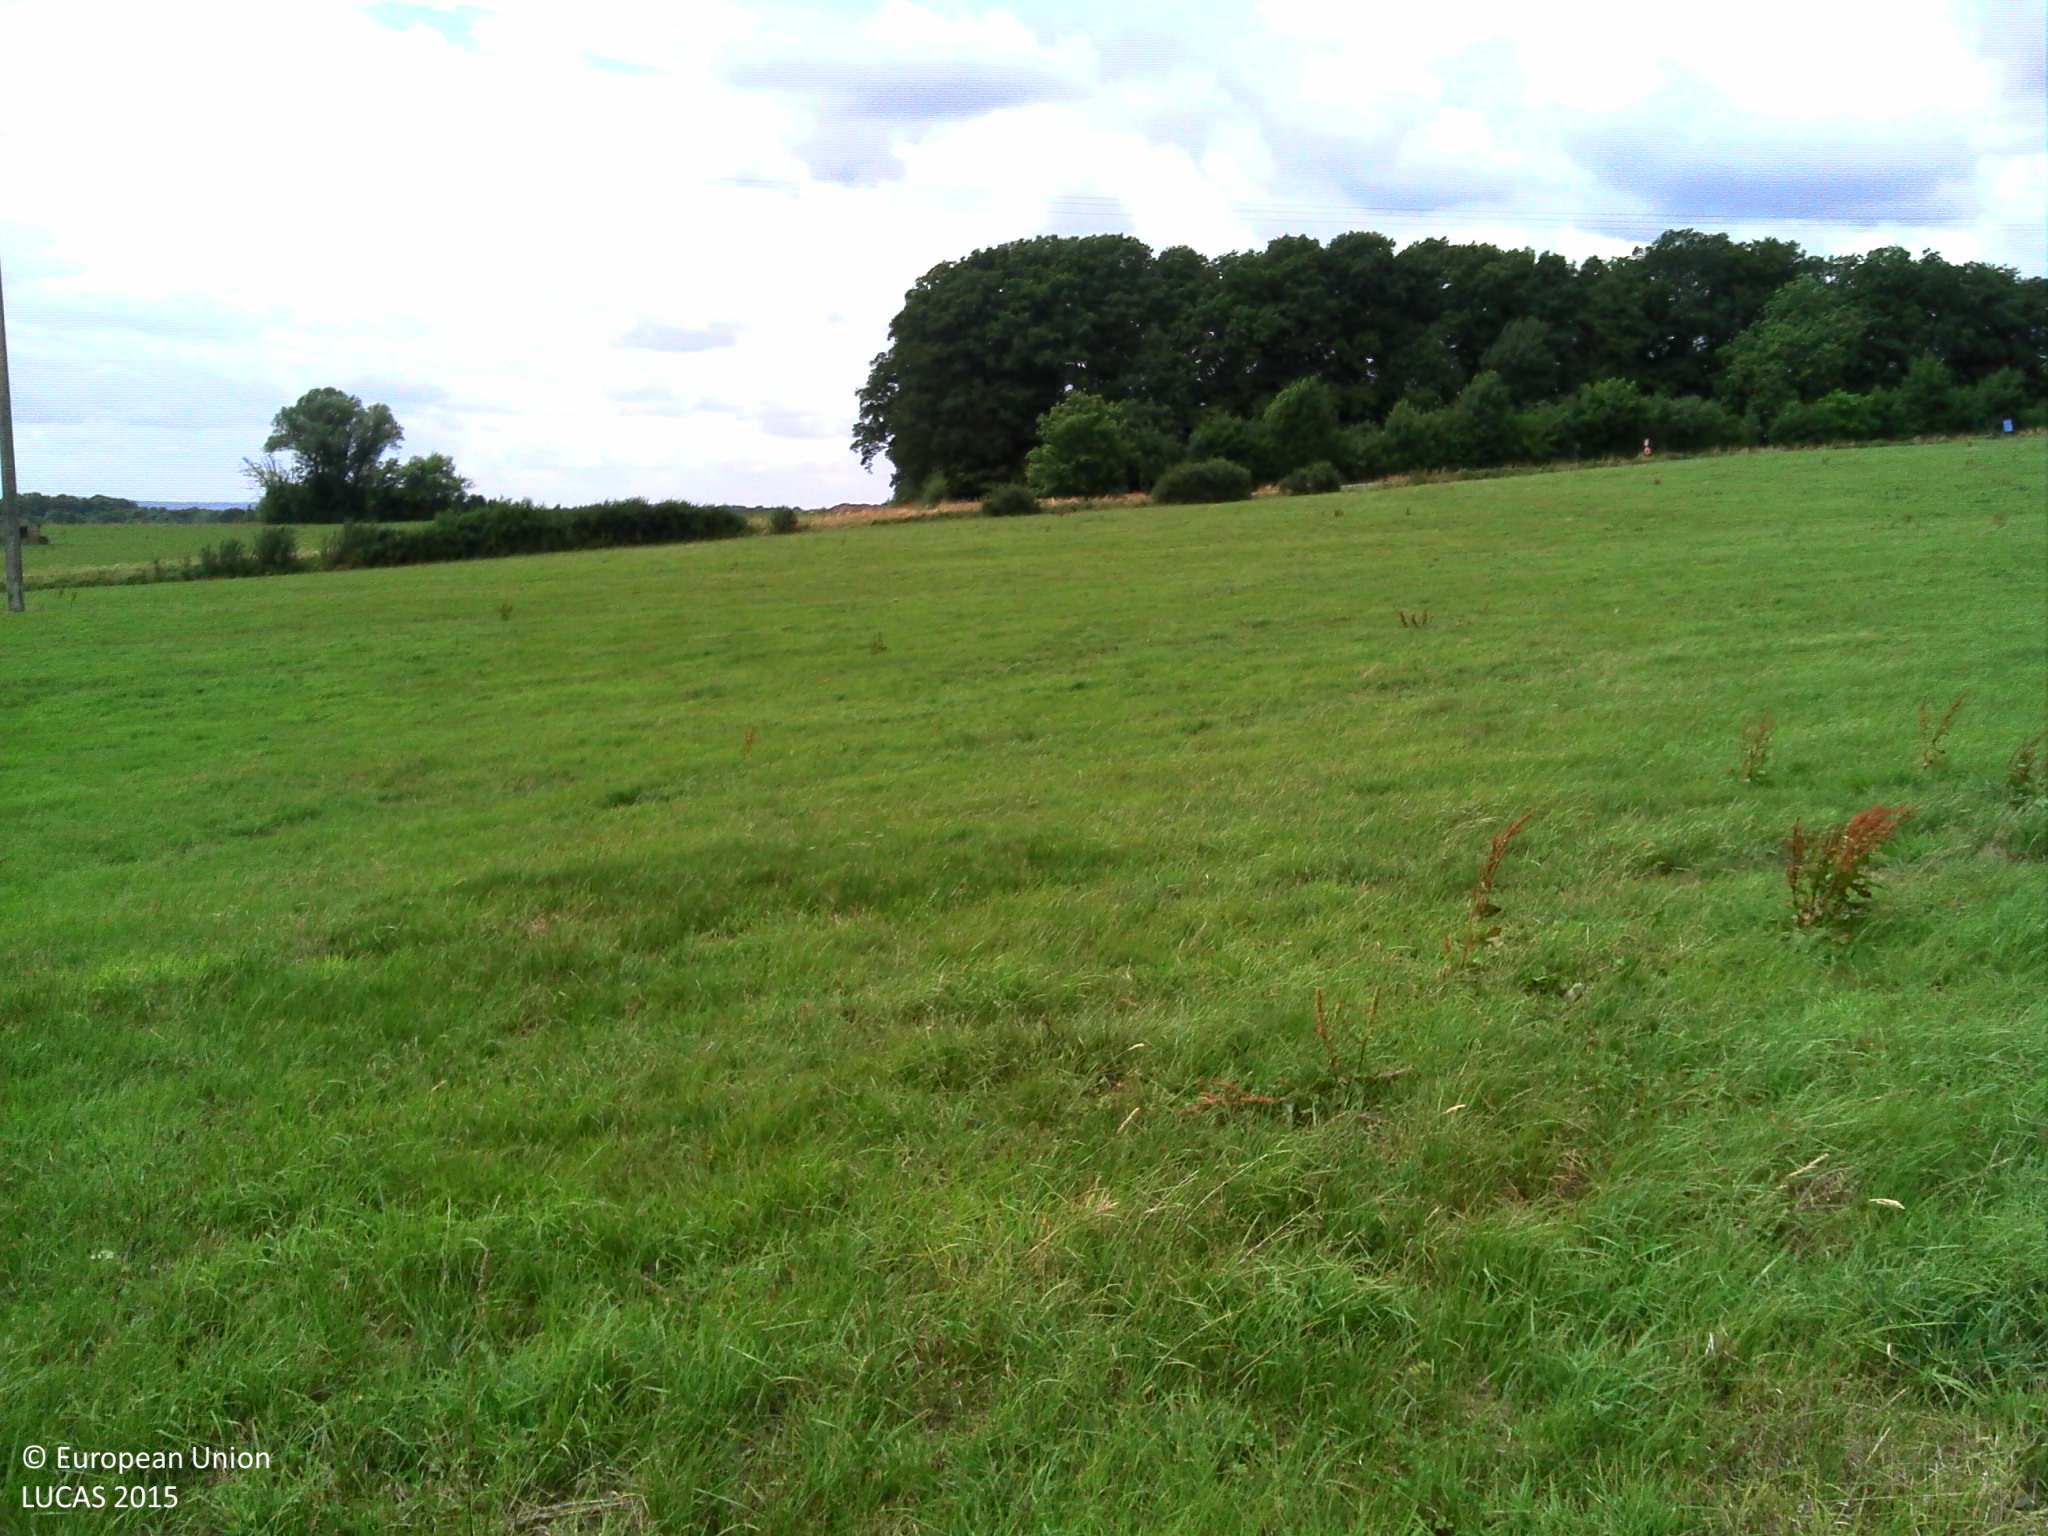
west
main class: Grassland
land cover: Grassland without tree/shrub cover
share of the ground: > 75 %
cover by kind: herbaceous plants 100 %
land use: Agriculture (excluding fallow land and kitchen gardens)
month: July
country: BE
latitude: 49.5977
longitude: 5.6682
